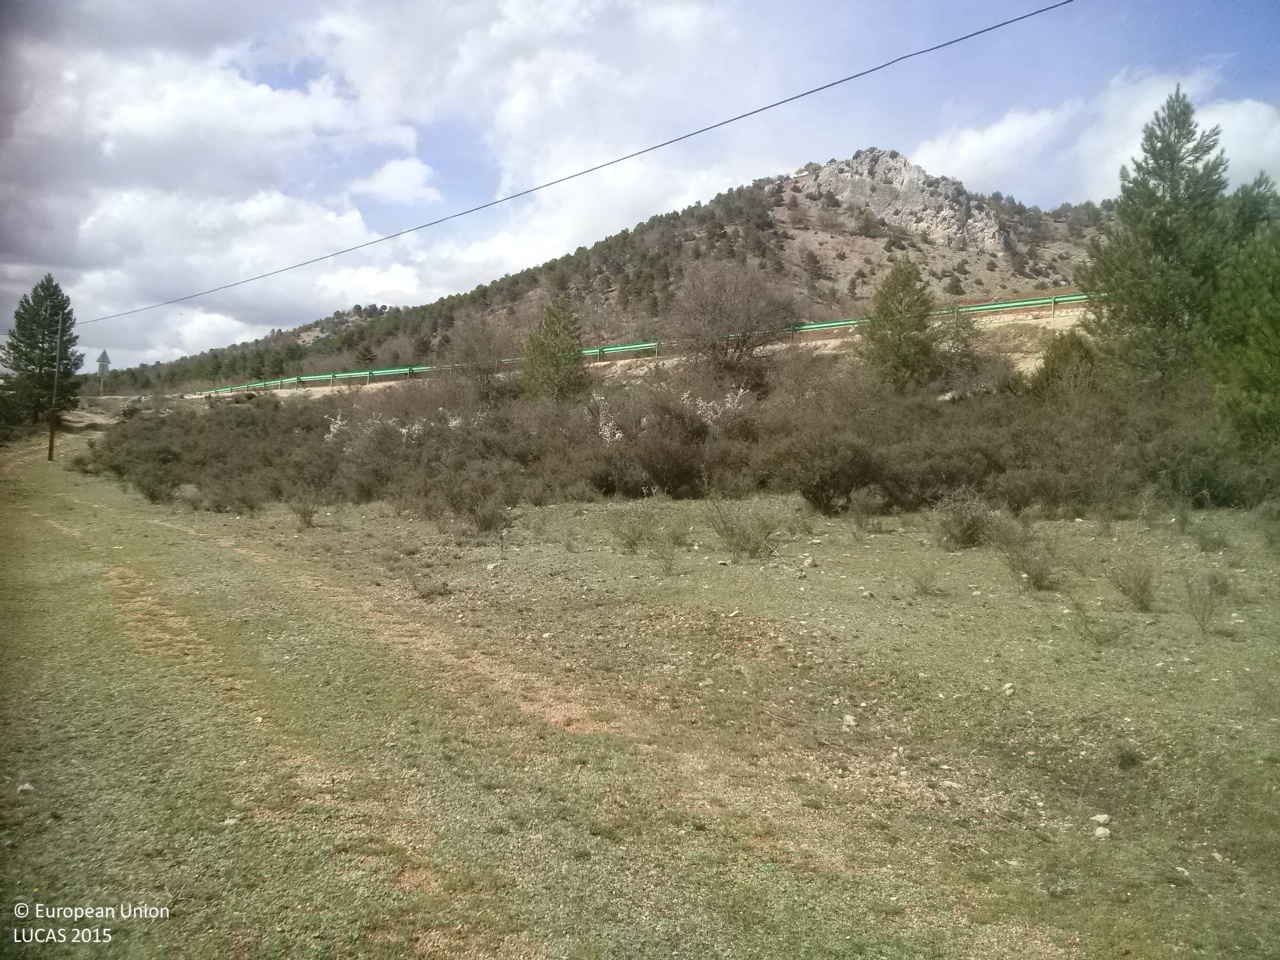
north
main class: Woodland
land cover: Pine dominated coniferous woodland
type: coniferous forest of the mediterranean region
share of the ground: > 75 %
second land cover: Grassland without tree/shrub cover
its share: 10 - 25 %
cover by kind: coniferous forest trees 80 %, shrubs 10 %, herbaceous plants 10 %
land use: Forestry
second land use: Agriculture (excluding fallow land and kitchen gardens)
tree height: > 5 m
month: April
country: ES
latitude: 40.2844
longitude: -1.7892
